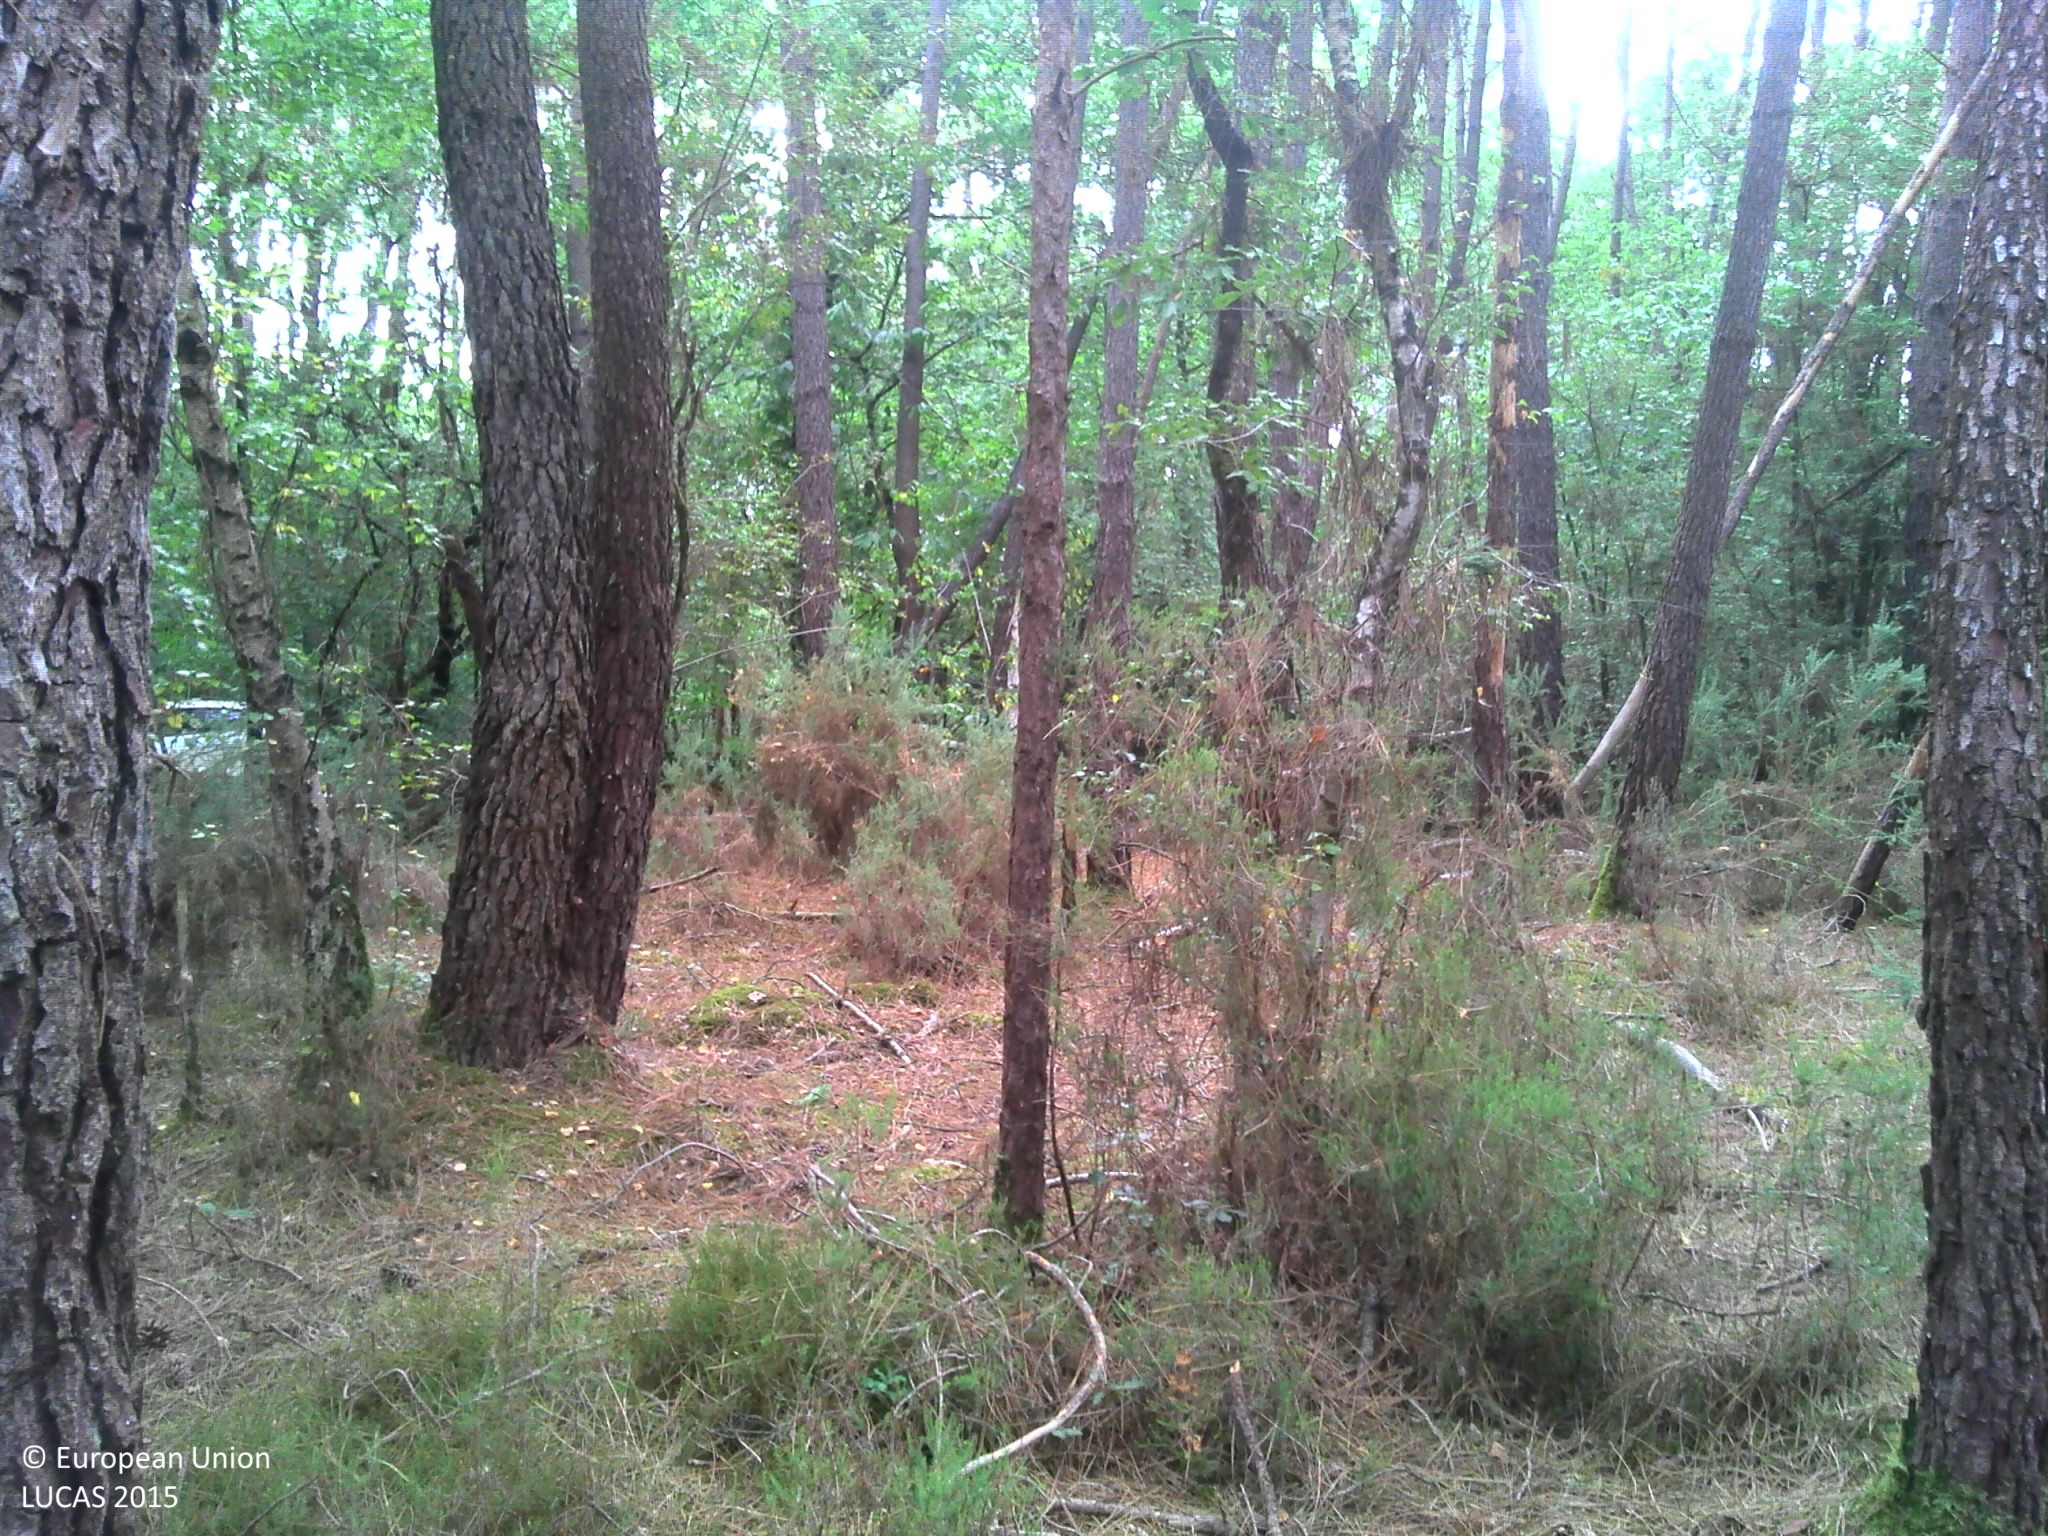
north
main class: Woodland
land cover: Pine dominated mixed woodland
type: hemiboreal forest and nemoral coniferous forest and mixed broadleaved-coniferous forest
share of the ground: > 75 %
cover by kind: coniferous forest trees 50 %, broadleaved forest trees 20 %, shrubs 15 %, herbaceous plants 10 %, lichens and mosses 5 %
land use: Forestry
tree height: > 5 m
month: July
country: FR
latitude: 46.9900
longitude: 0.4208
